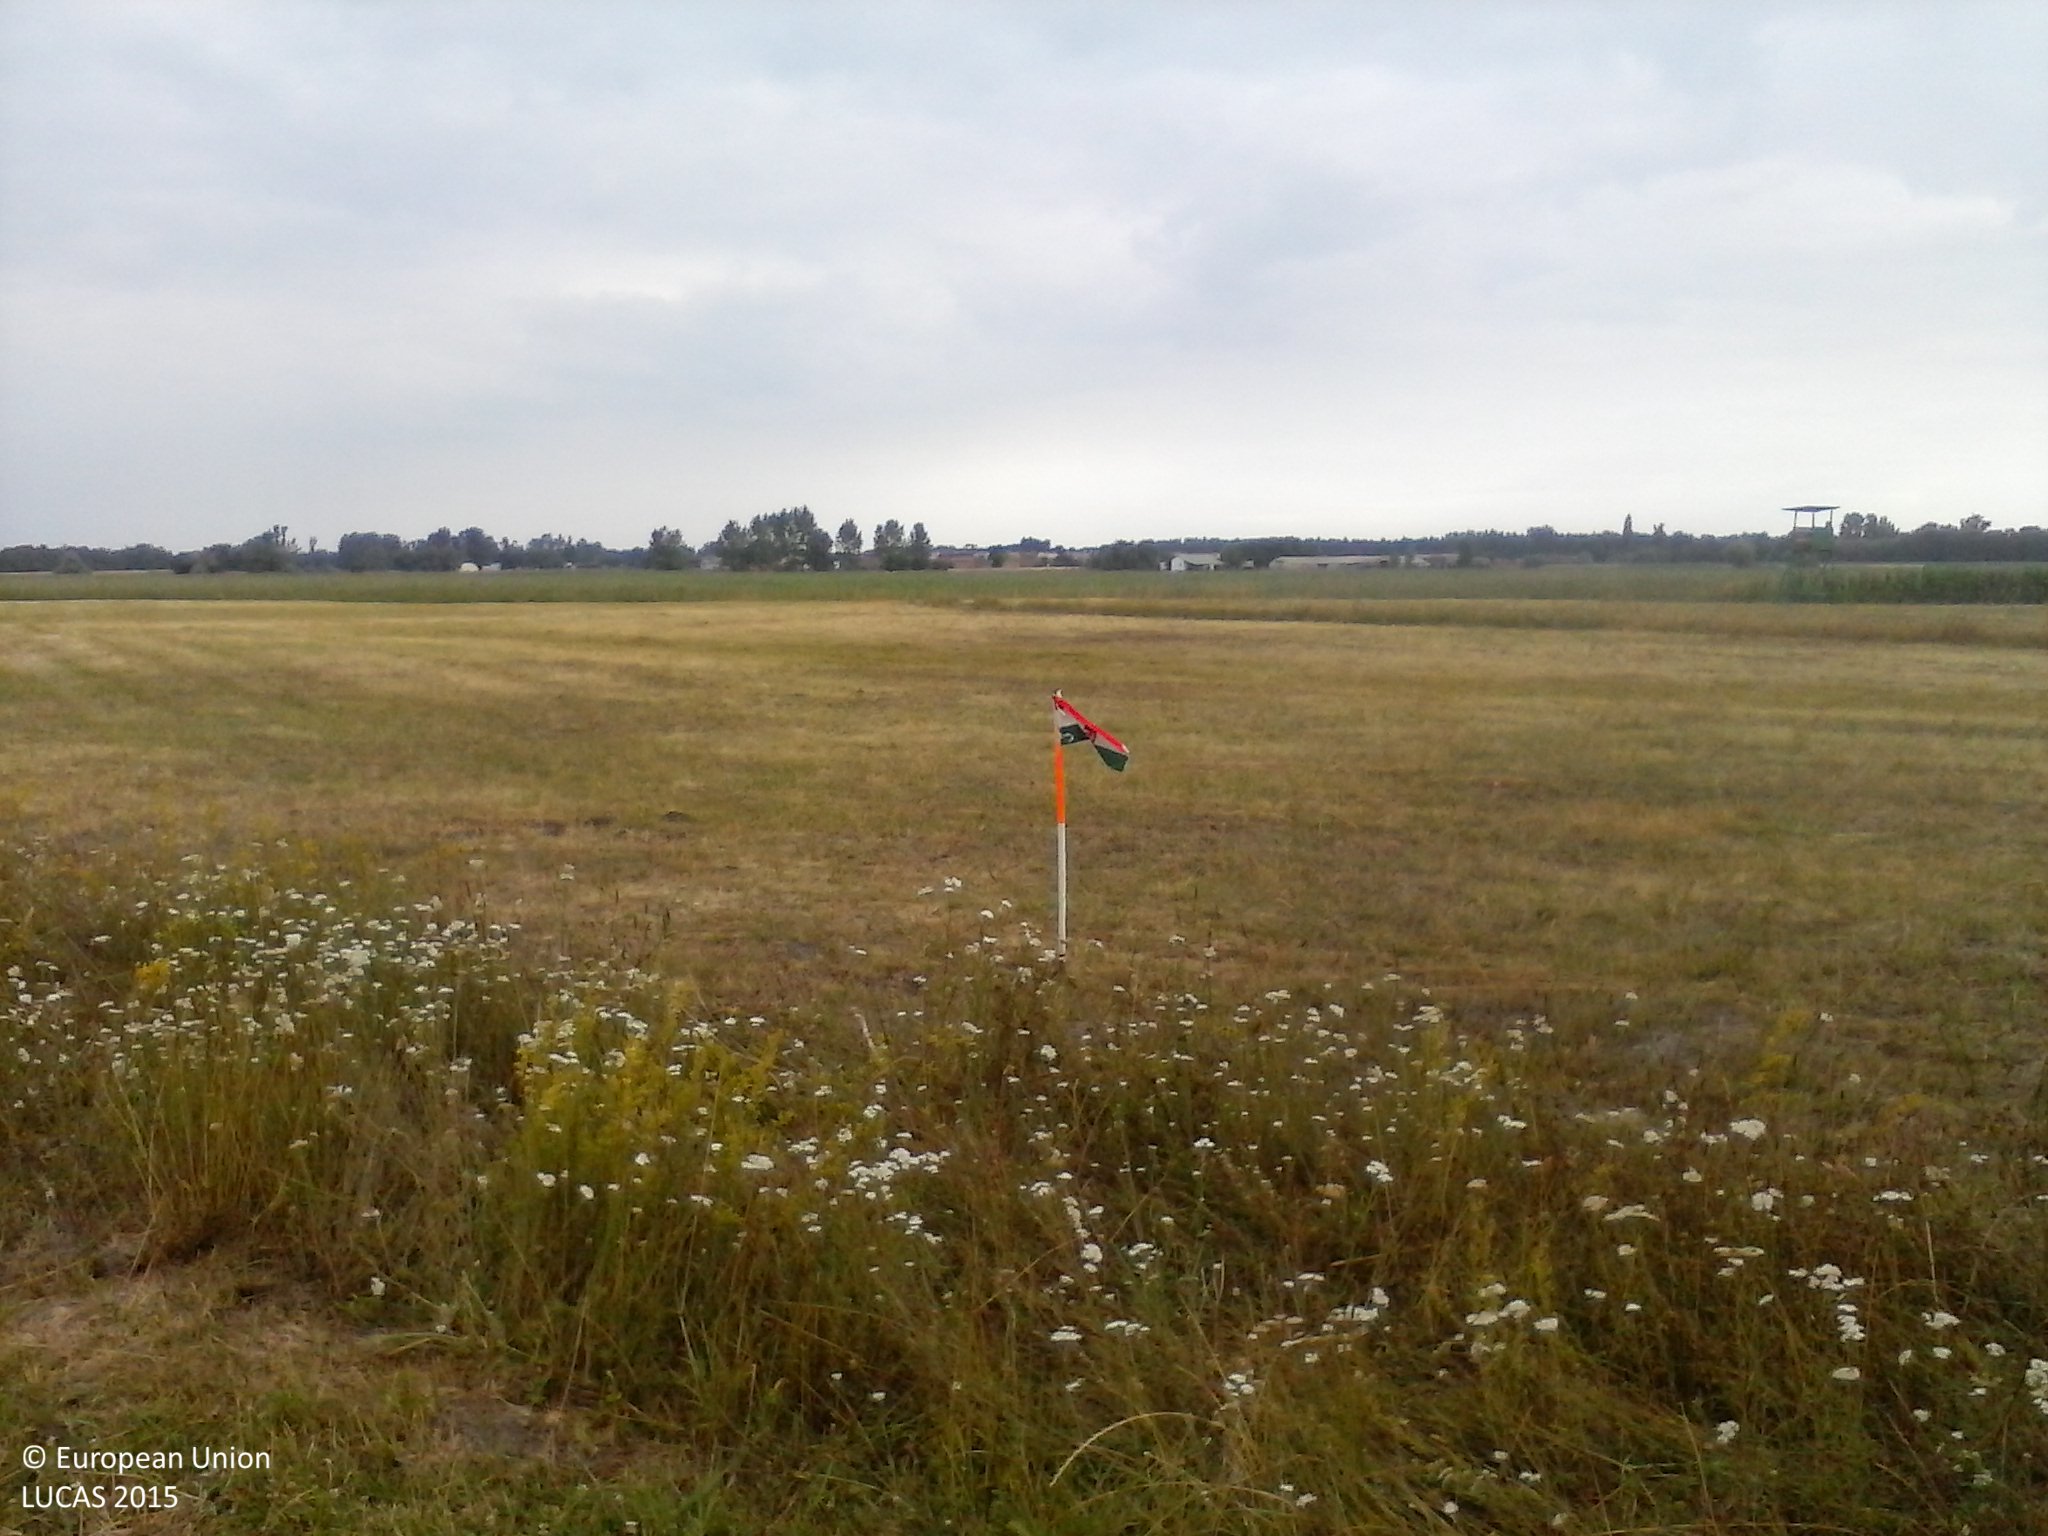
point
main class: Grassland
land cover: Grassland without tree/shrub cover
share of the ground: > 75 %
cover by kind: herbaceous plants 100 %
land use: Agriculture (excluding fallow land and kitchen gardens)
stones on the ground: < 10 %
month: July
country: HU
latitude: 46.4836
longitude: 19.5662
